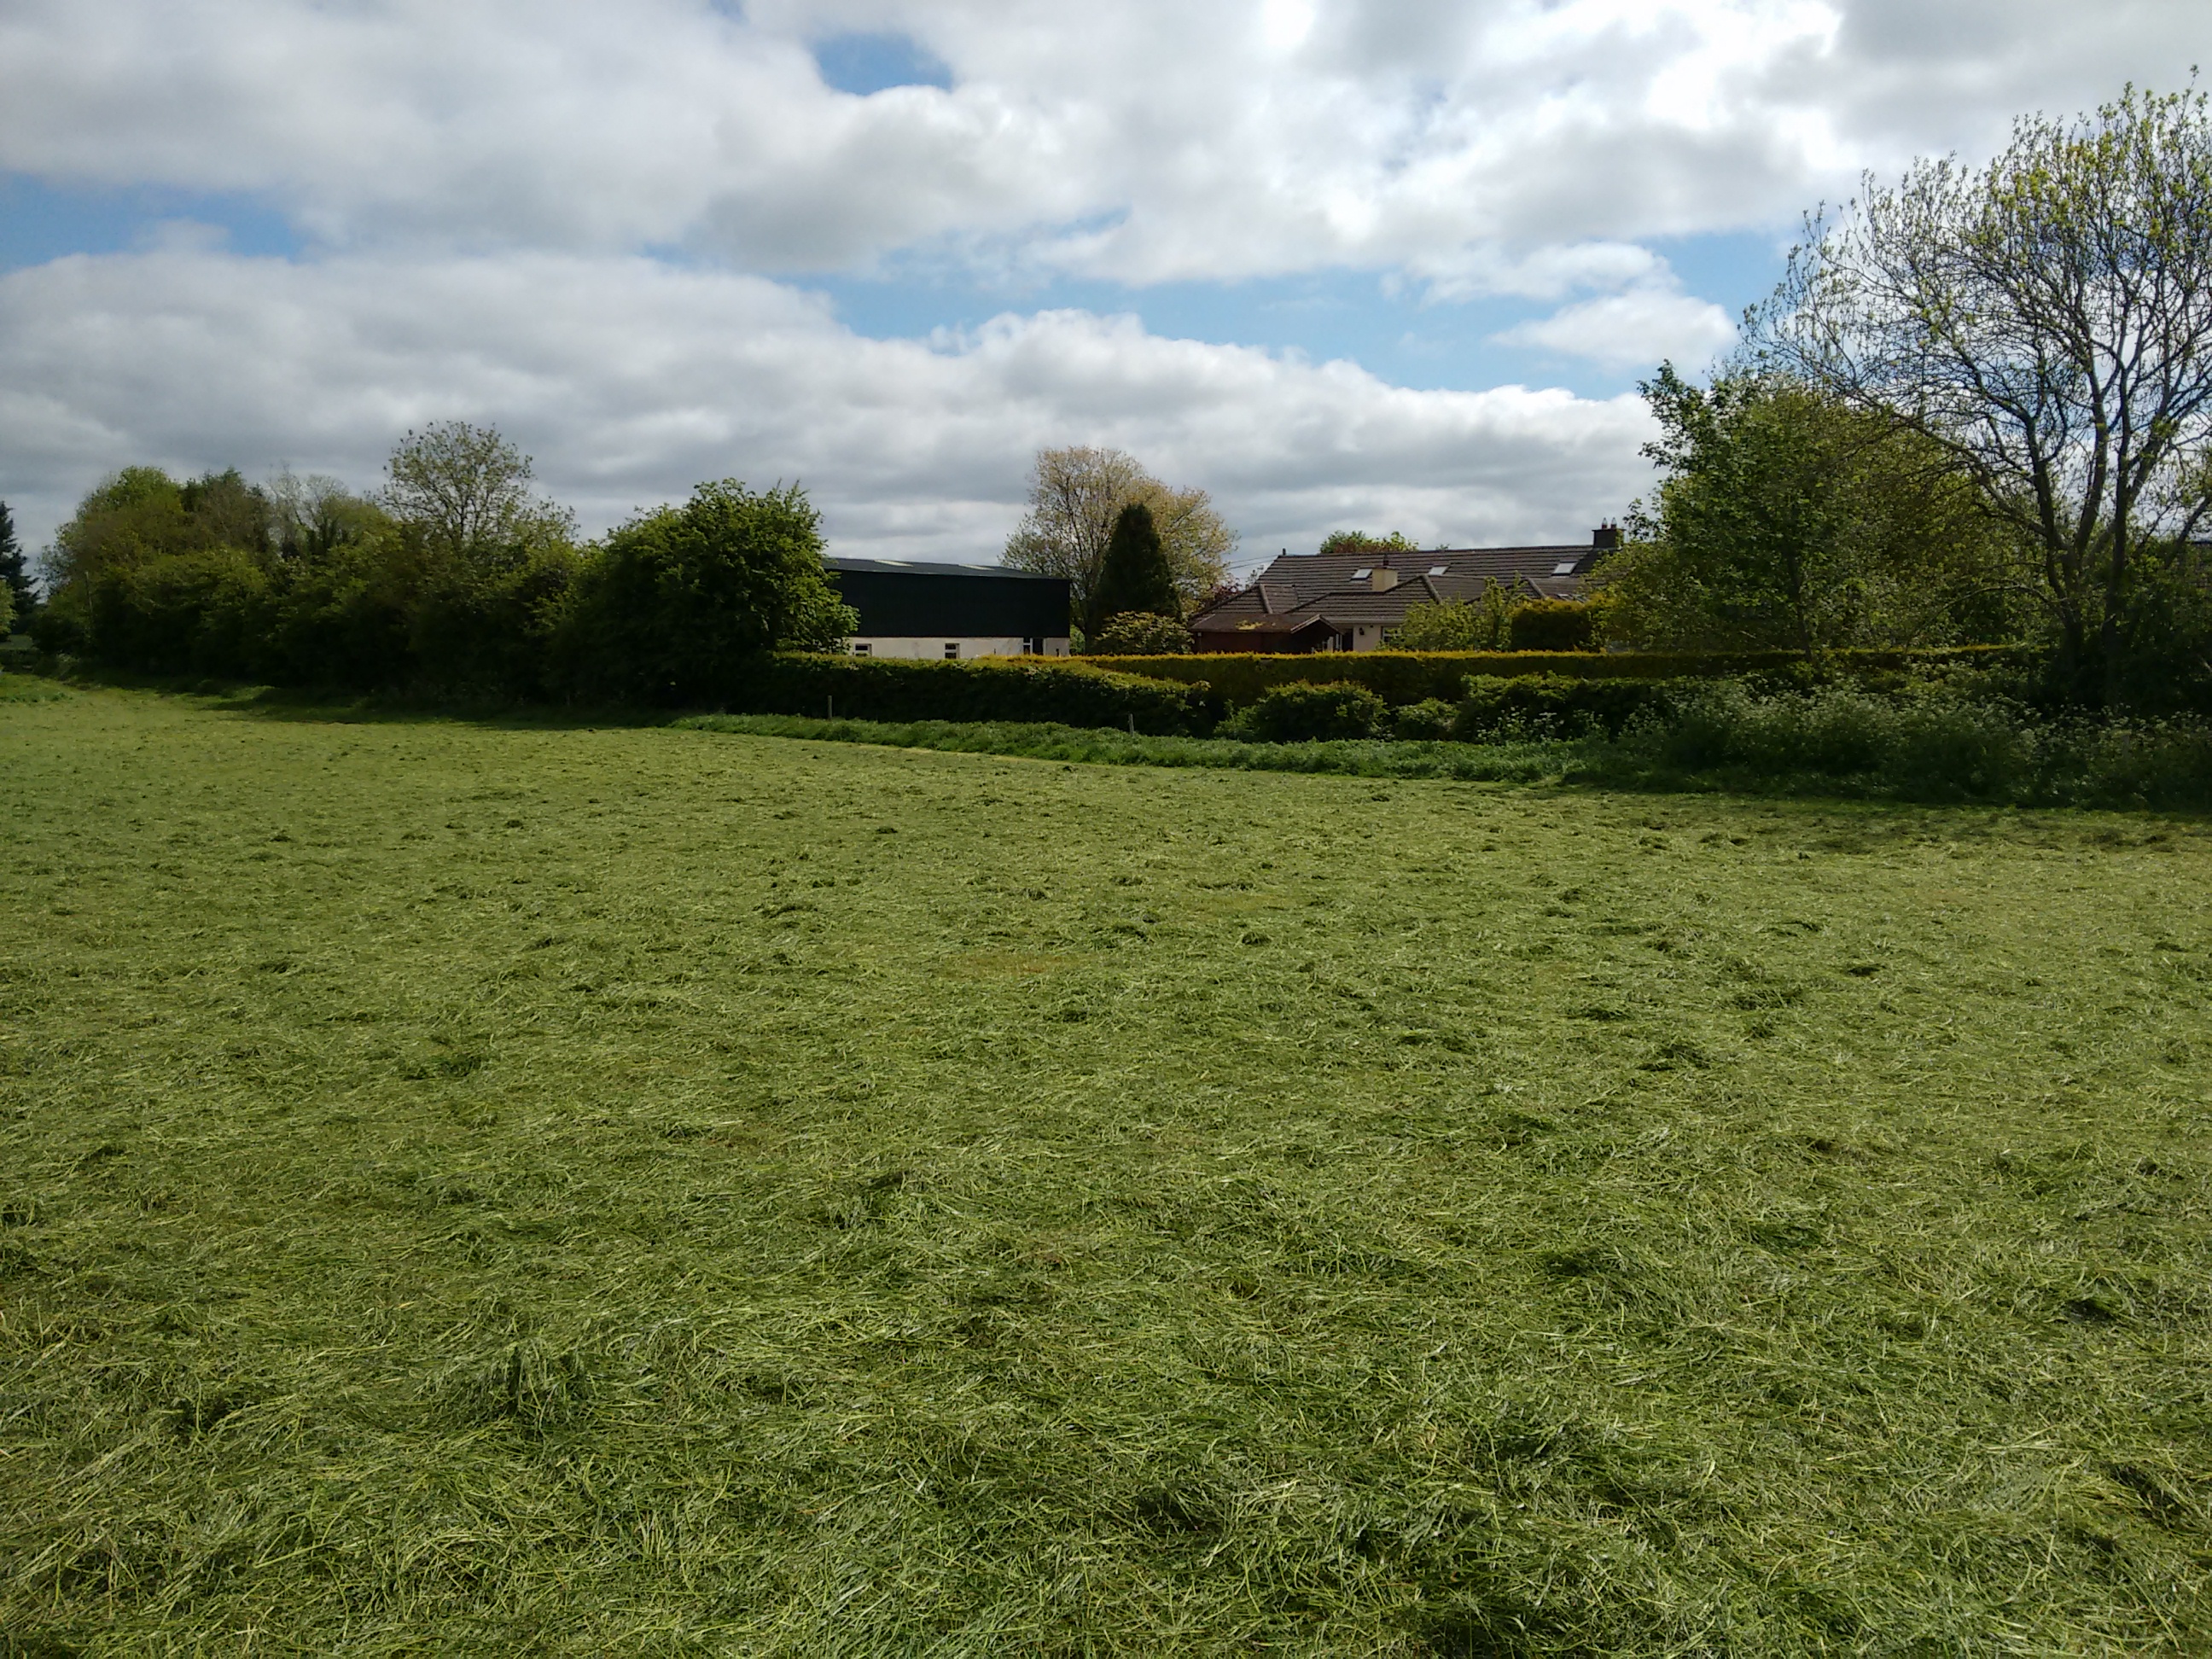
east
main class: Cropland
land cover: Barley
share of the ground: > 75 %
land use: Agriculture (excluding fallow land and kitchen gardens)
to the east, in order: Barley; Artificial constructions in urban areas; Managed hedges; Barley; Electric lines; Barley; Electric lines; Grassland with sparse tree/shrub cover; Barley
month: May
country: IE
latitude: 53.4938
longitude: -6.6048
